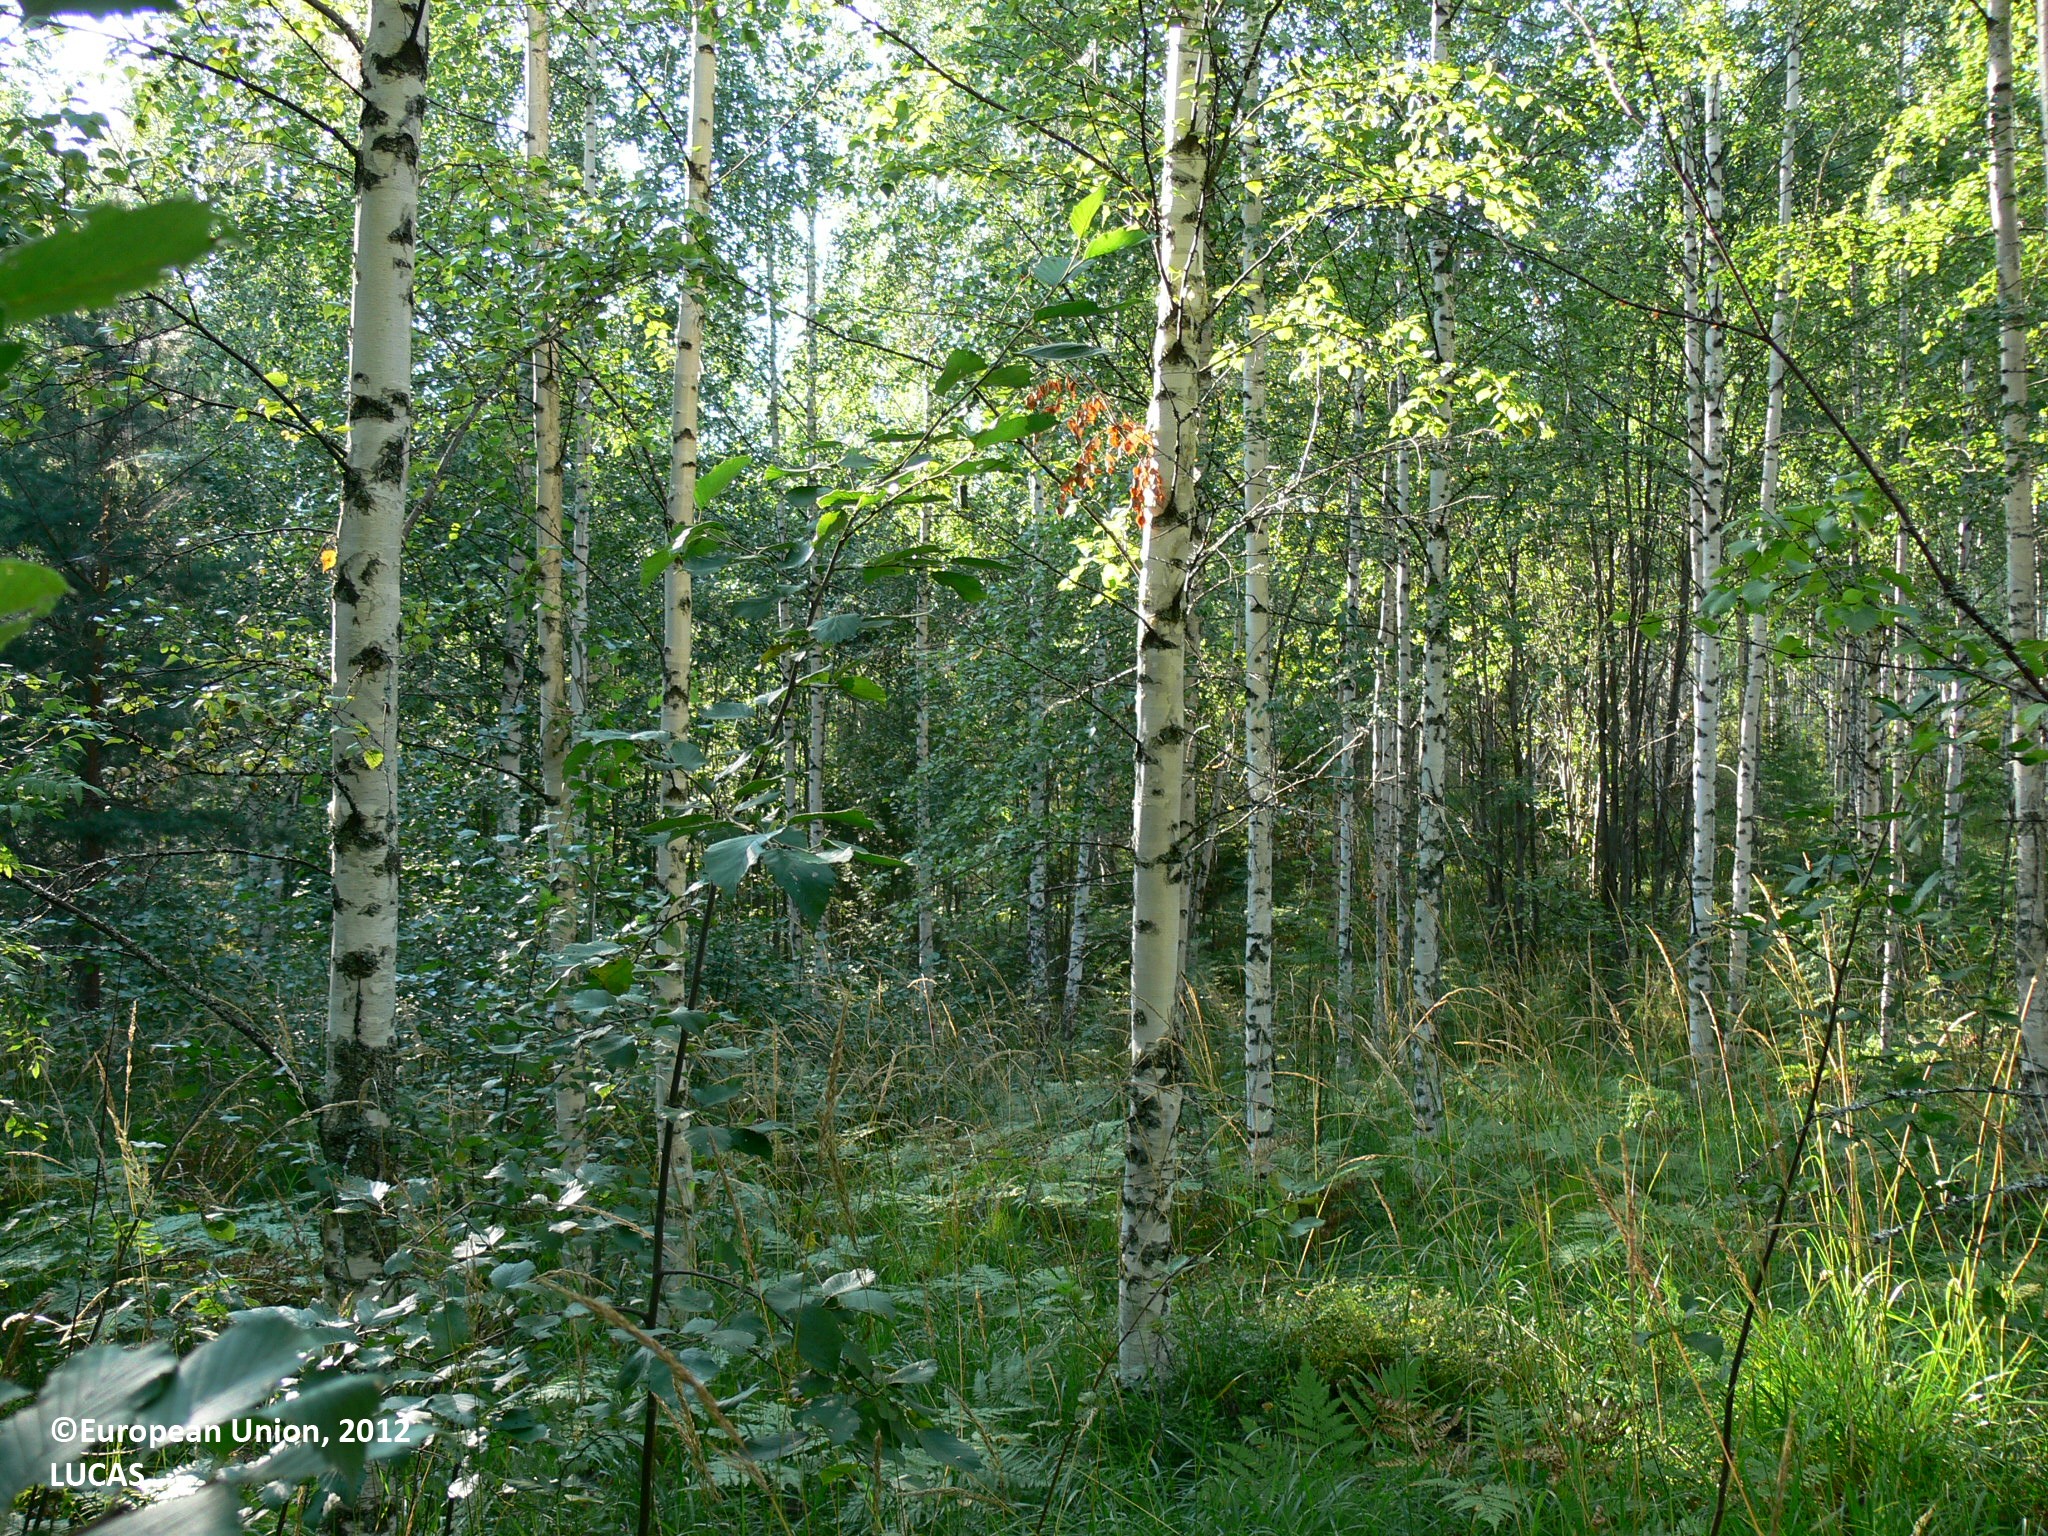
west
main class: Woodland
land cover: Broadleaved woodland
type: boreal forest
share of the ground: > 75 %
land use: Forestry
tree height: > 5 m
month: August
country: FI
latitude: 61.8715
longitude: 29.9446
